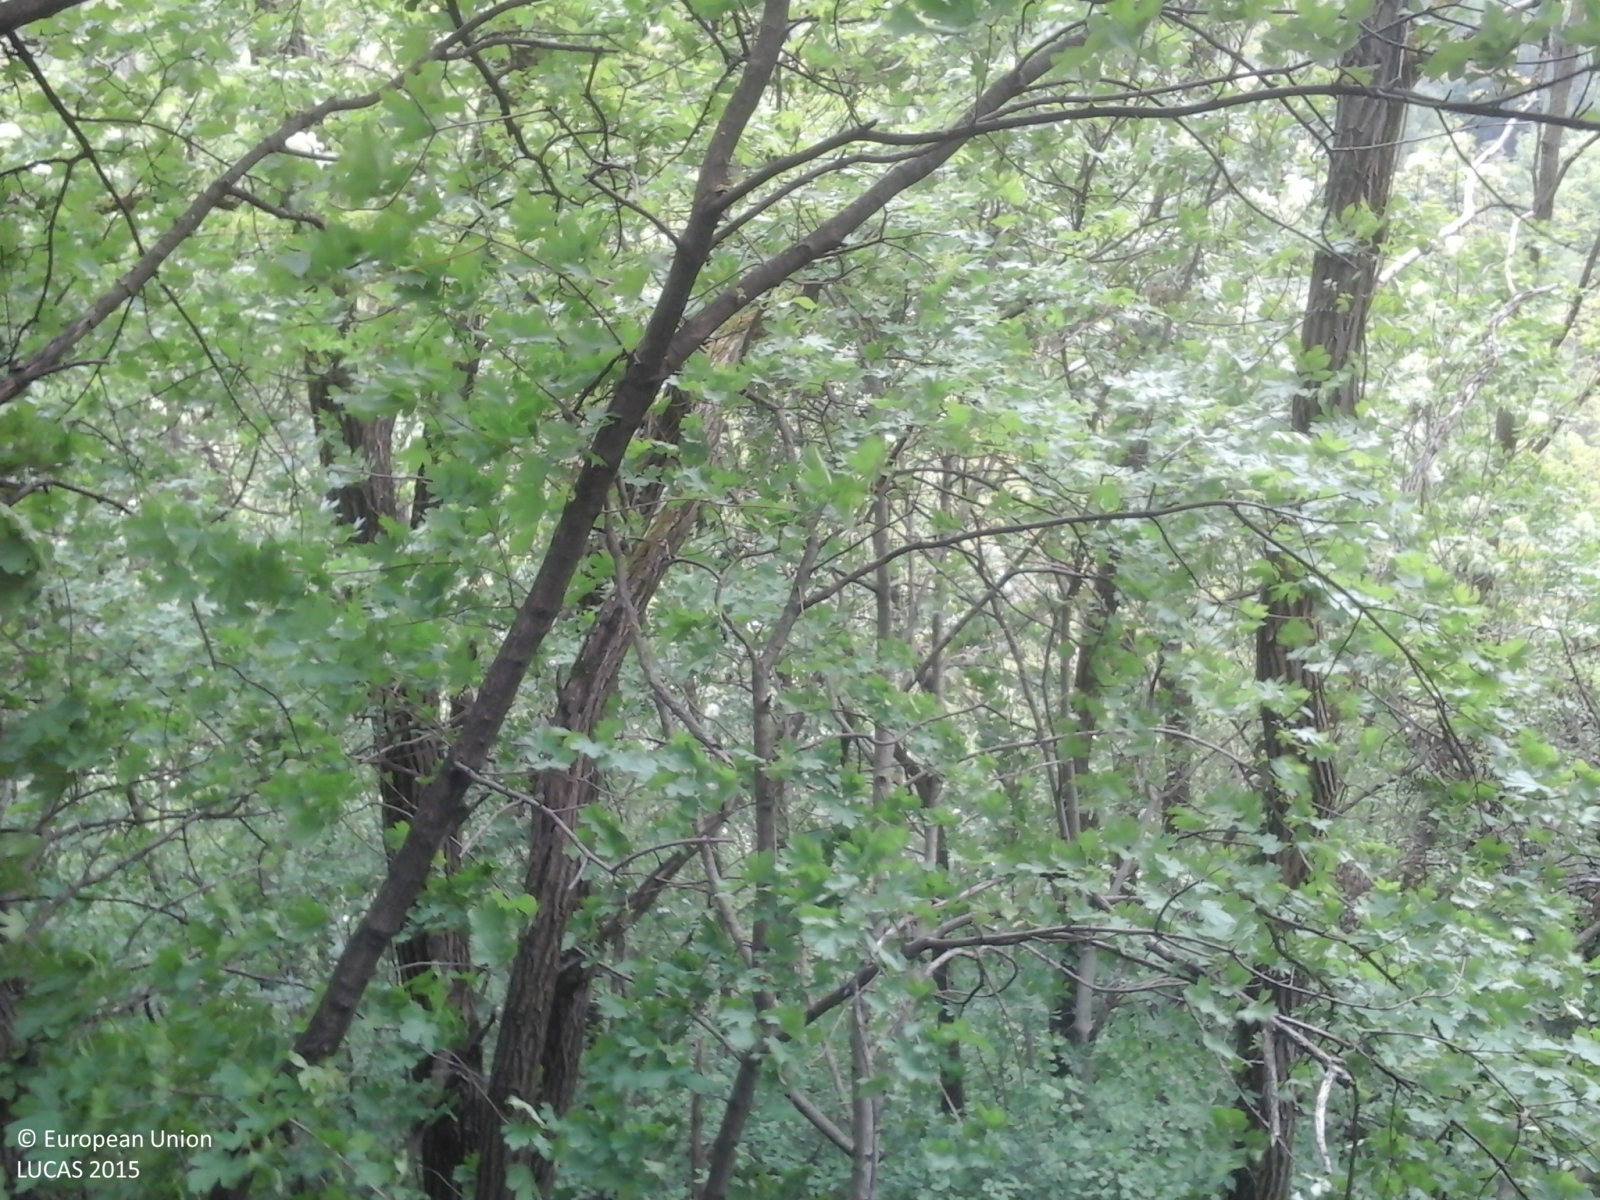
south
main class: Woodland
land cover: Broadleaved woodland
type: thermophilous deciduous forest
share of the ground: > 75 %
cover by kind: broadleaved forest trees 100 %
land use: Forestry
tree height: > 5 m
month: April
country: IT
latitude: 46.2737
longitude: 11.0756
